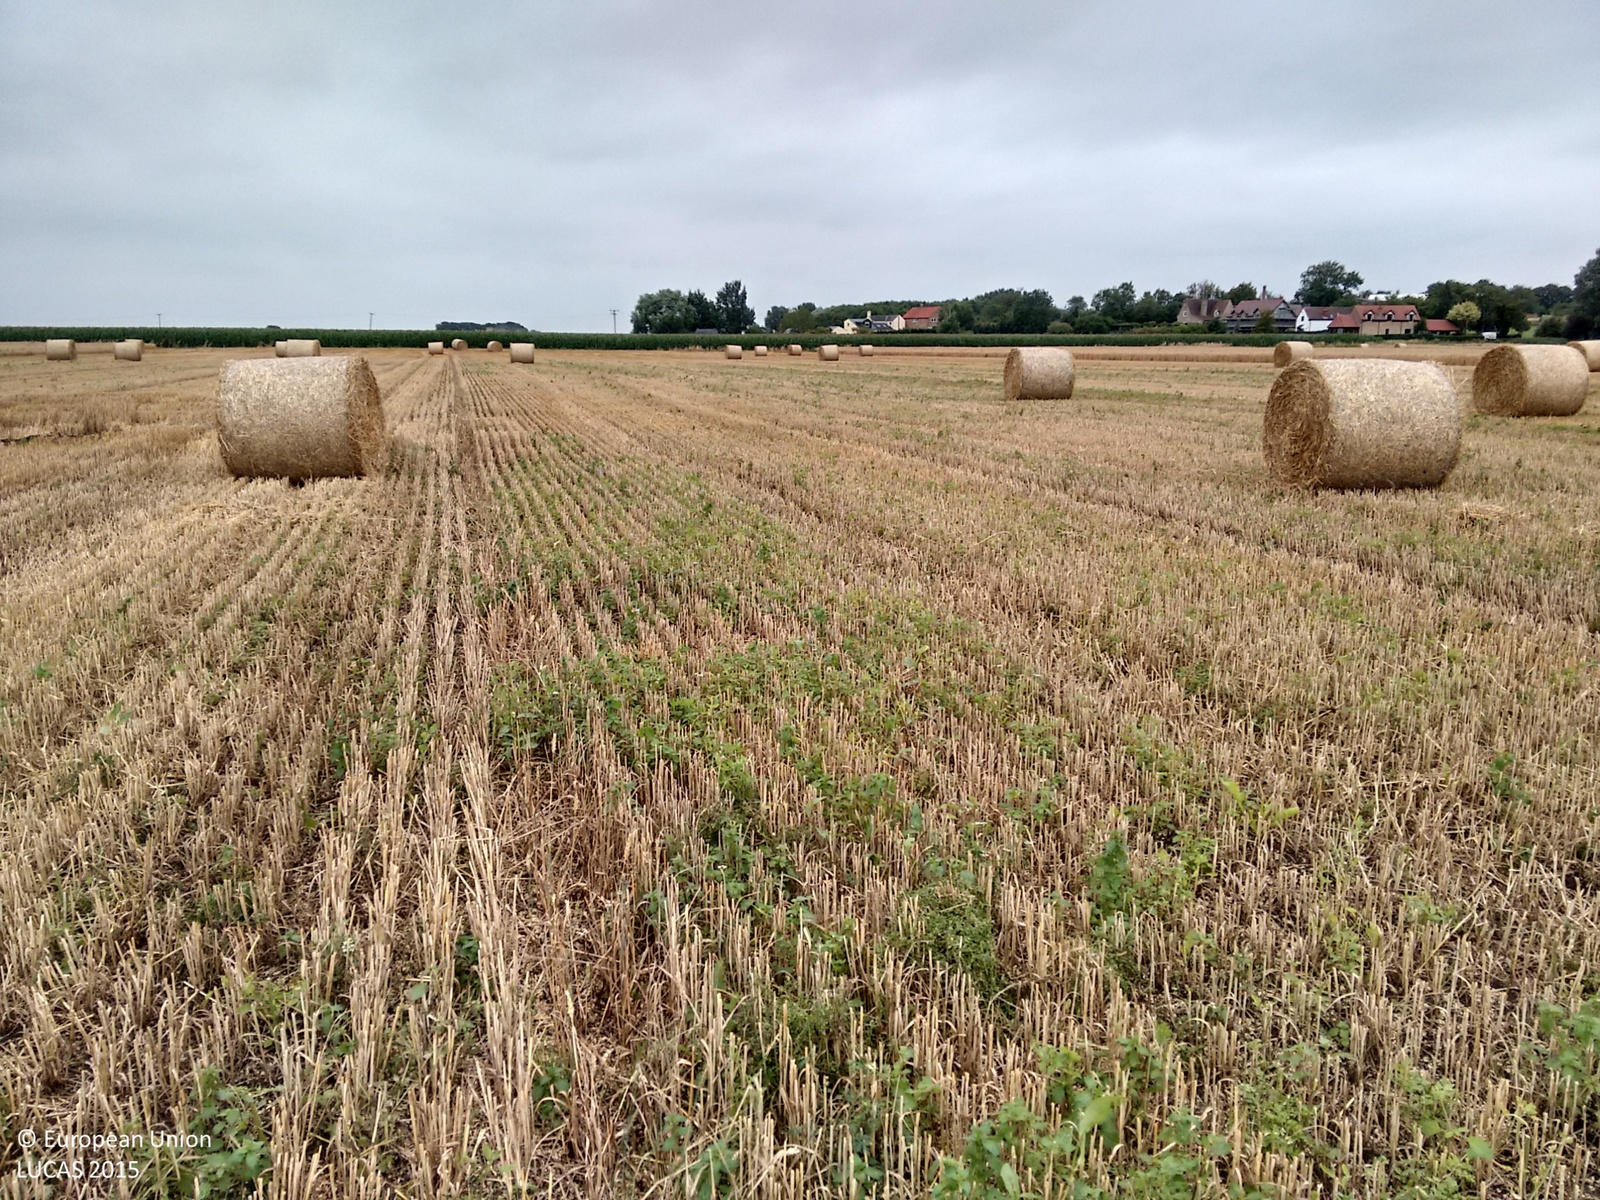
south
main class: Cropland
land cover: Common wheat
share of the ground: > 75 %
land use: Agriculture (excluding fallow land and kitchen gardens)
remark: Harvested field
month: August
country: GB
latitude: 52.4231
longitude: 0.1905
